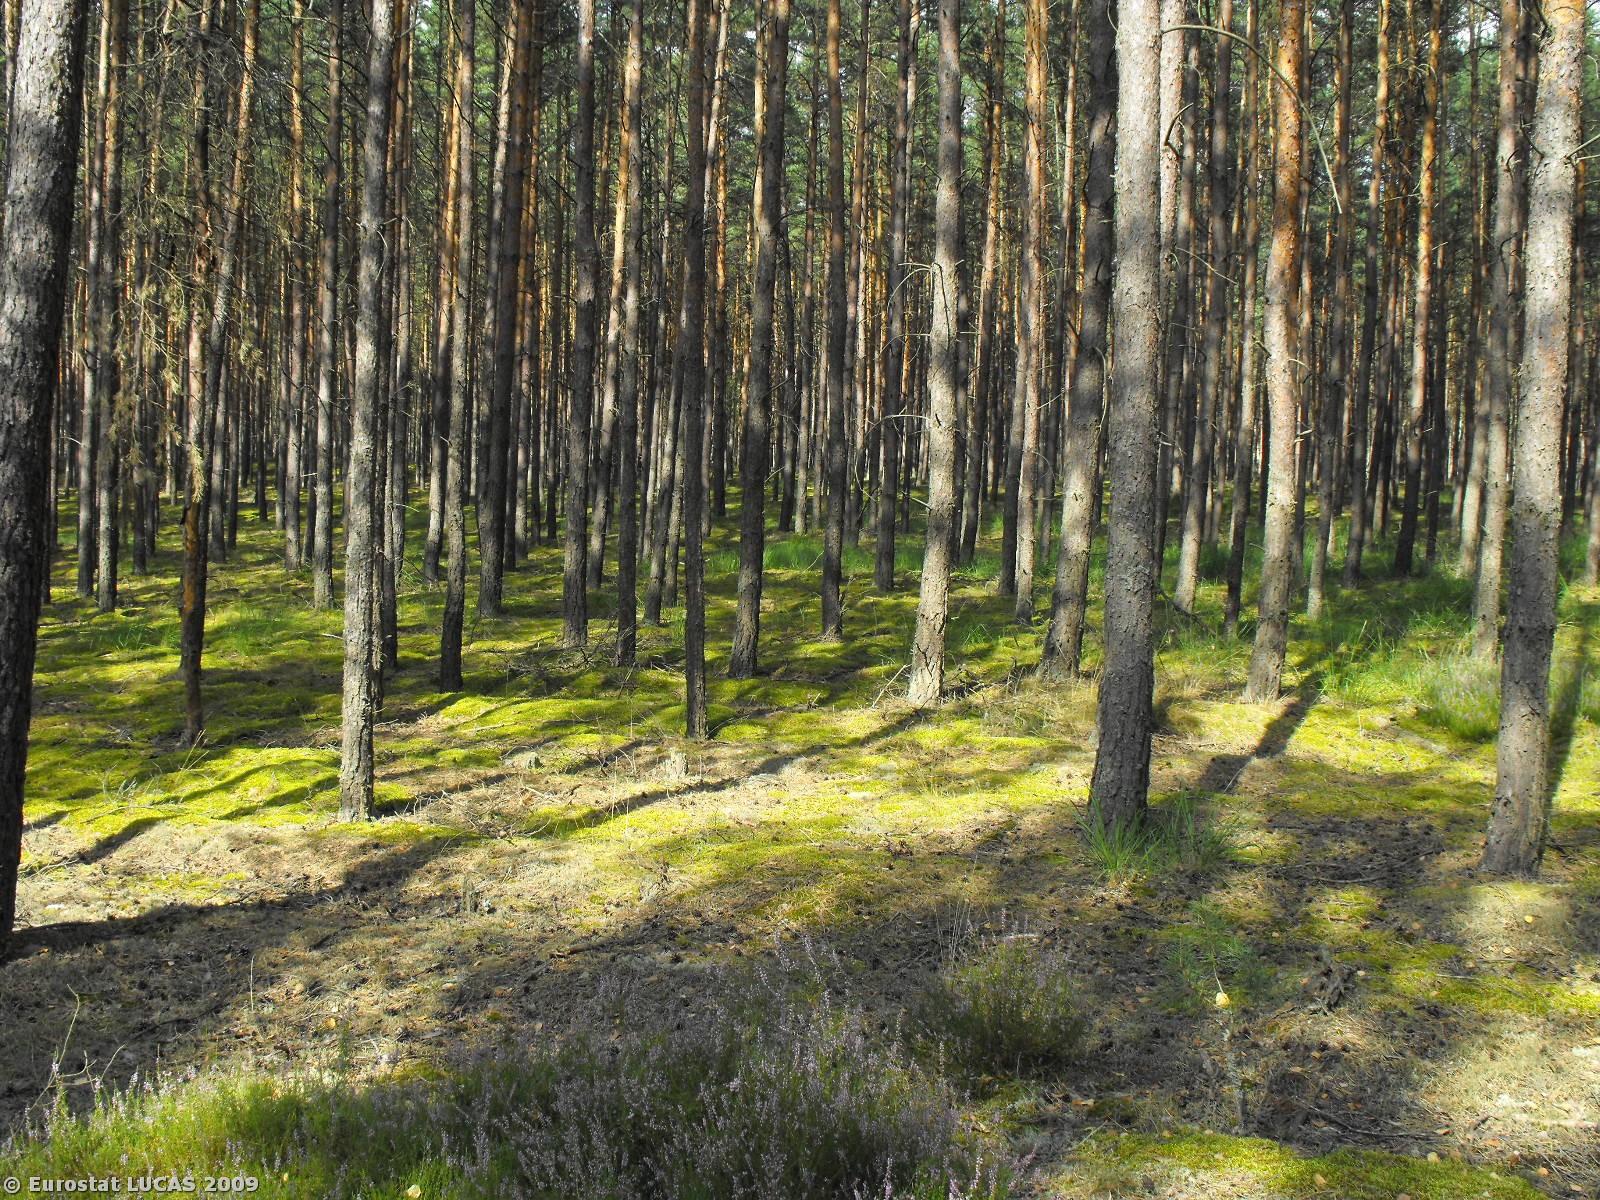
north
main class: Woodland
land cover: Coniferous woodland
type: hemiboreal forest and nemoral coniferous forest and mixed broadleaved-coniferous forest
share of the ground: 50 - 75 %
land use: Forestry
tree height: > 5 m
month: September
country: PL
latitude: 52.7820
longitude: 16.3969
